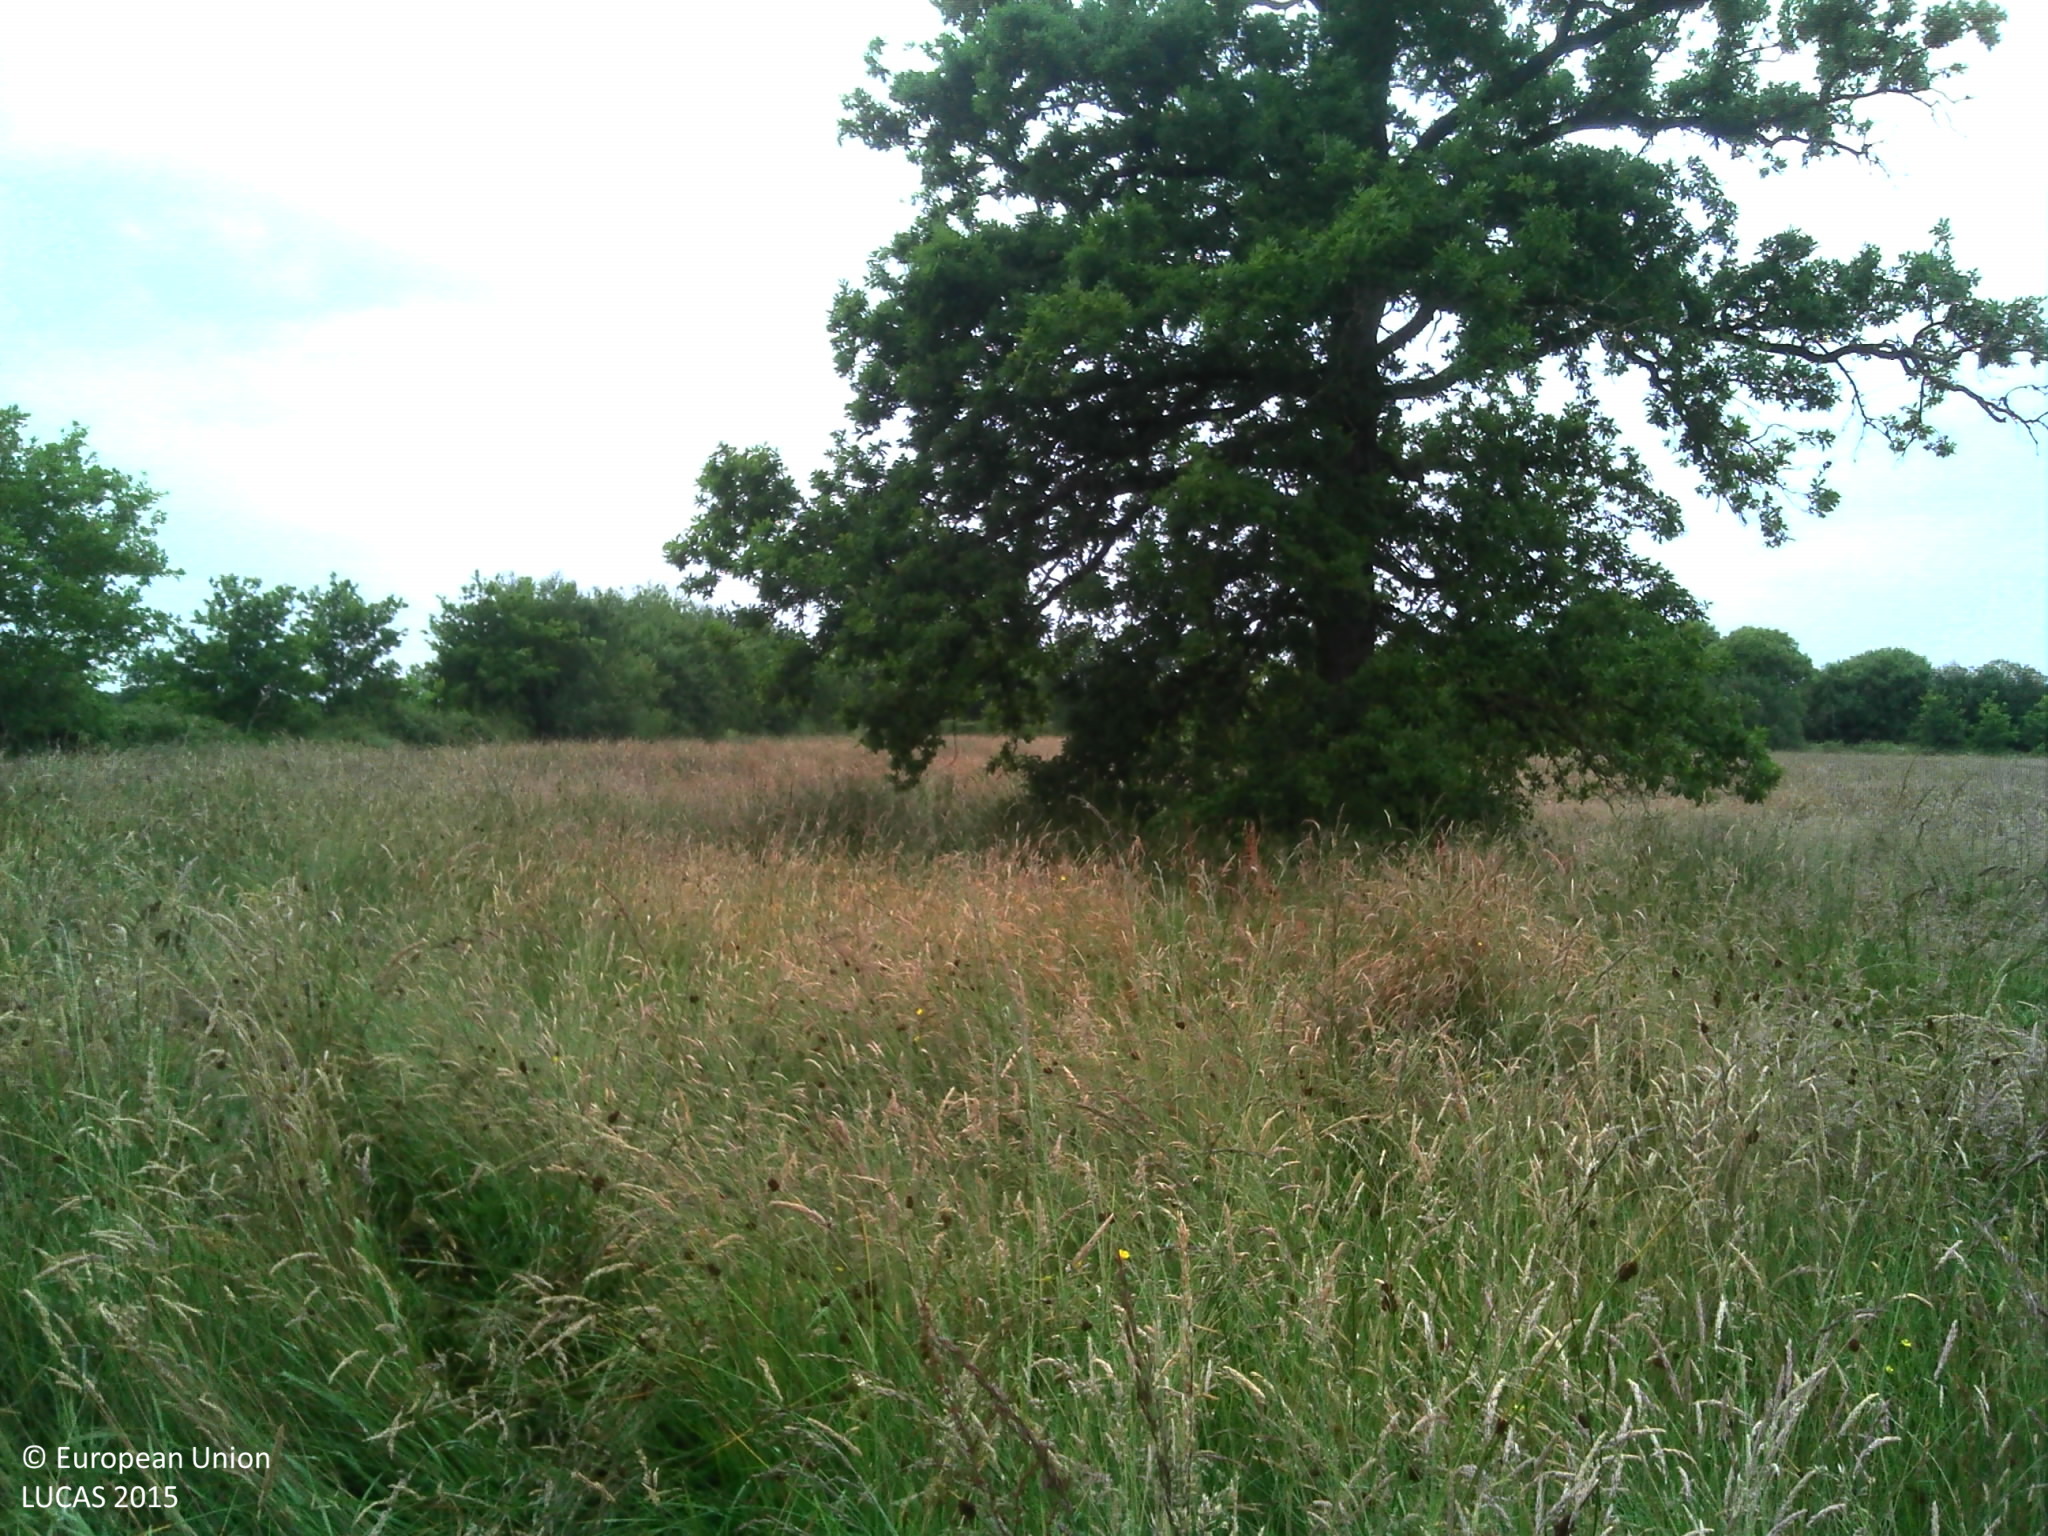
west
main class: Grassland
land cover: Grassland without tree/shrub cover
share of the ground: > 75 %
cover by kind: herbaceous plants 100 %
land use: Agriculture (excluding fallow land and kitchen gardens)
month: June
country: FR
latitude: 46.8581
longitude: -1.6497
